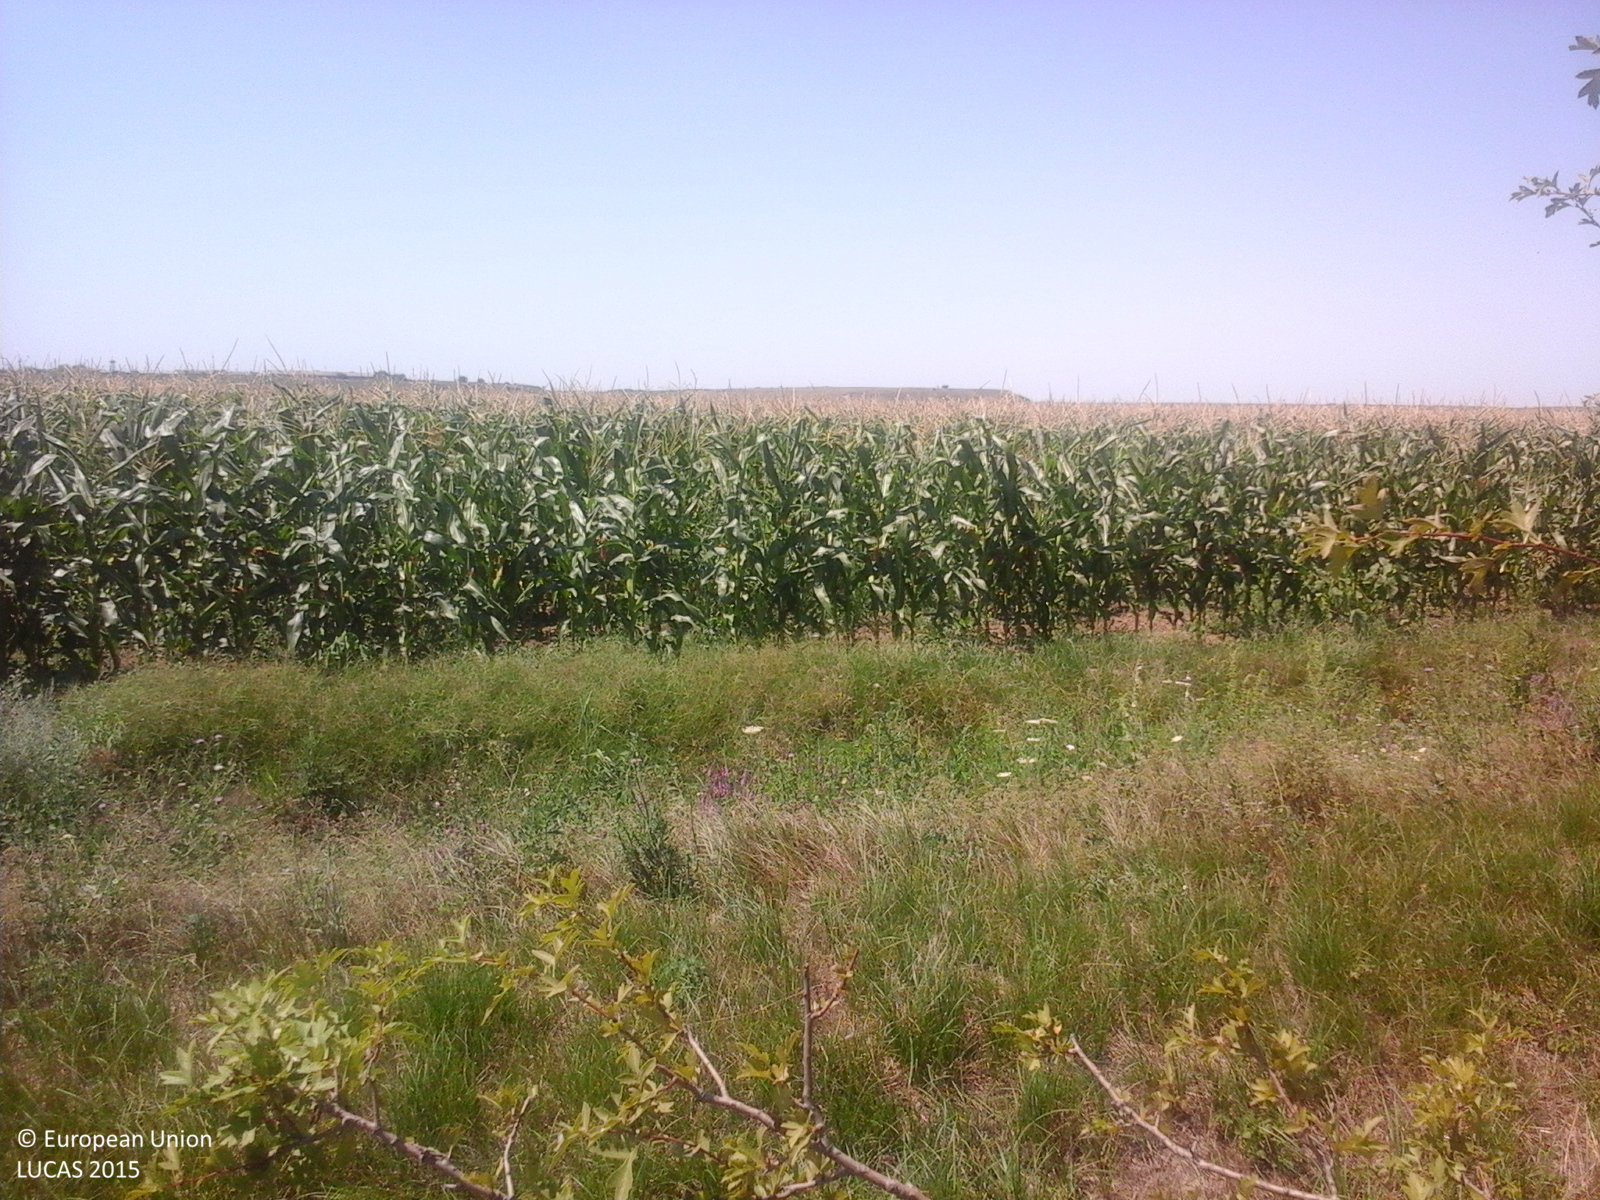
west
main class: Grassland
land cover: Grassland with sparse tree/shrub cover
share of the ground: > 75 %
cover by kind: herbaceous plants 85 %, shrubs 10 %, broadleaved forest trees 5 %
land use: Agriculture (excluding fallow land and kitchen gardens)
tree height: > 5 m
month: July
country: RO
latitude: 44.2608
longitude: 26.4327
